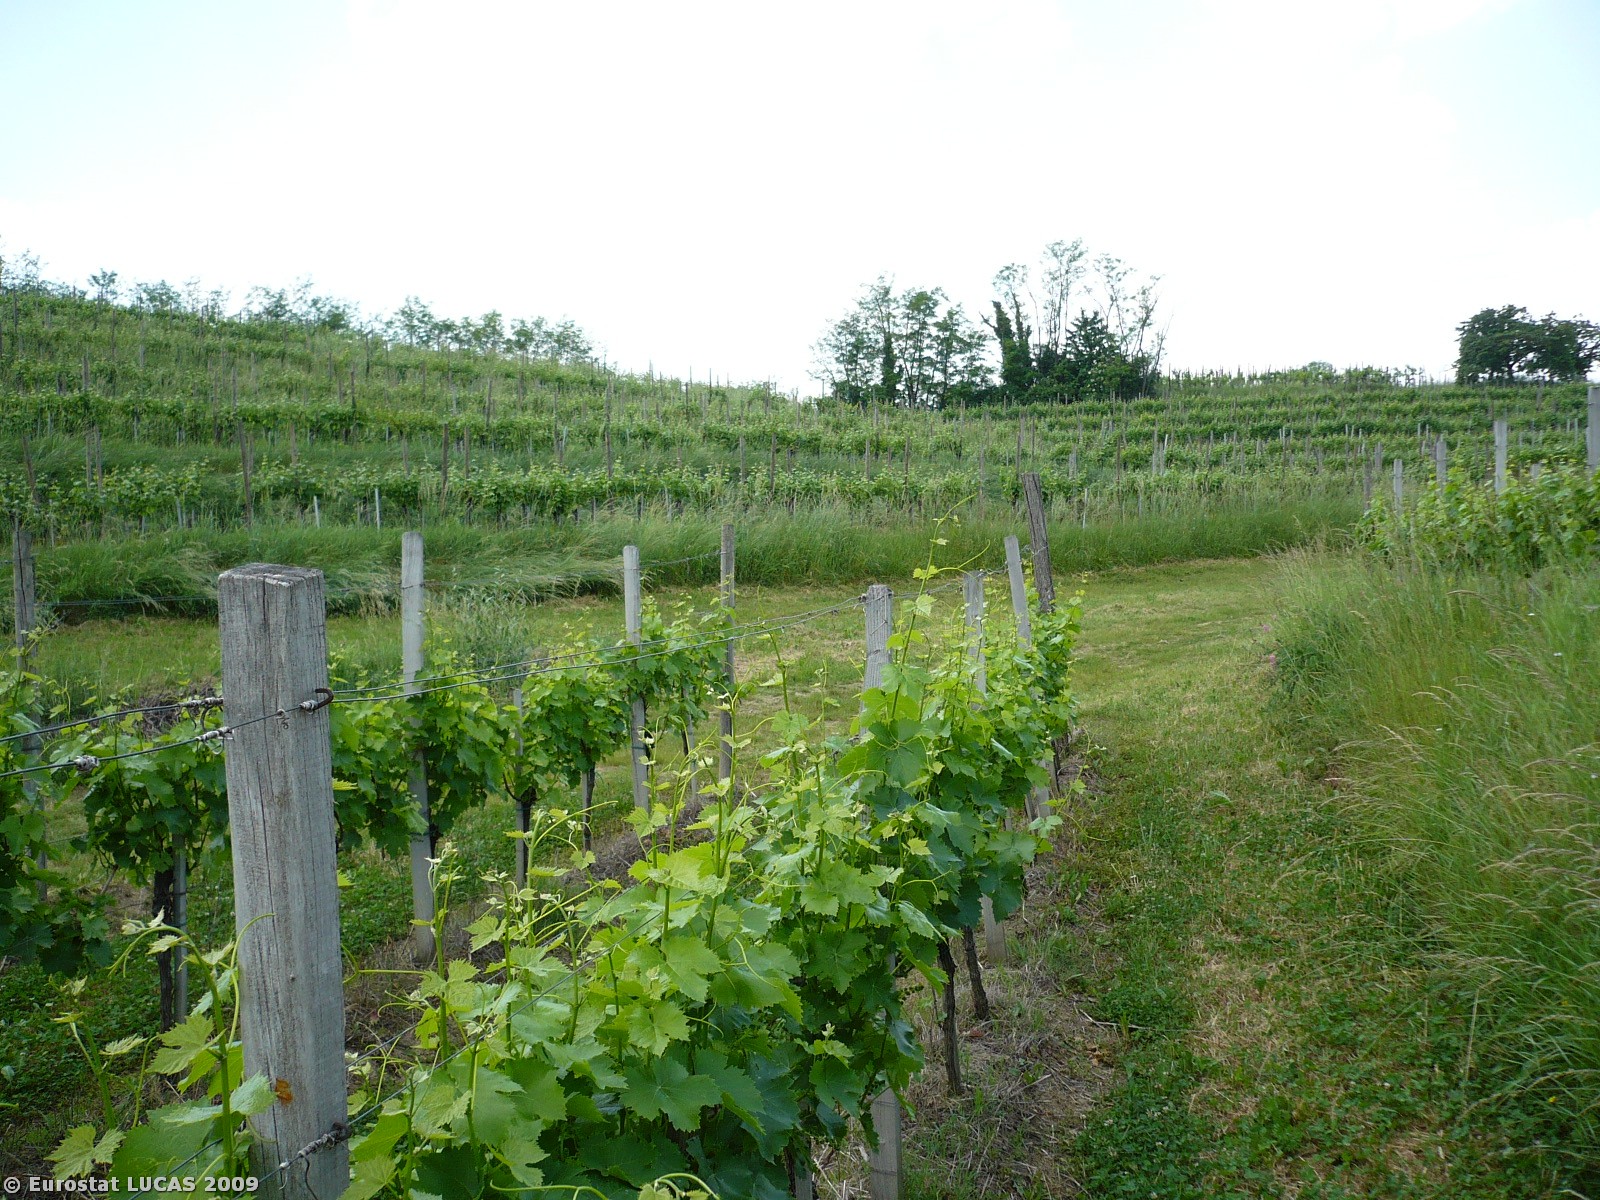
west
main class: Cropland
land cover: Vineyards
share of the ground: > 75 %
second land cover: Grassland with sparse tree/shrub cover
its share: > 75 %
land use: Agriculture (excluding fallow land and kitchen gardens)
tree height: < 5 m
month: May
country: SI
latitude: 45.9105
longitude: 13.6444
